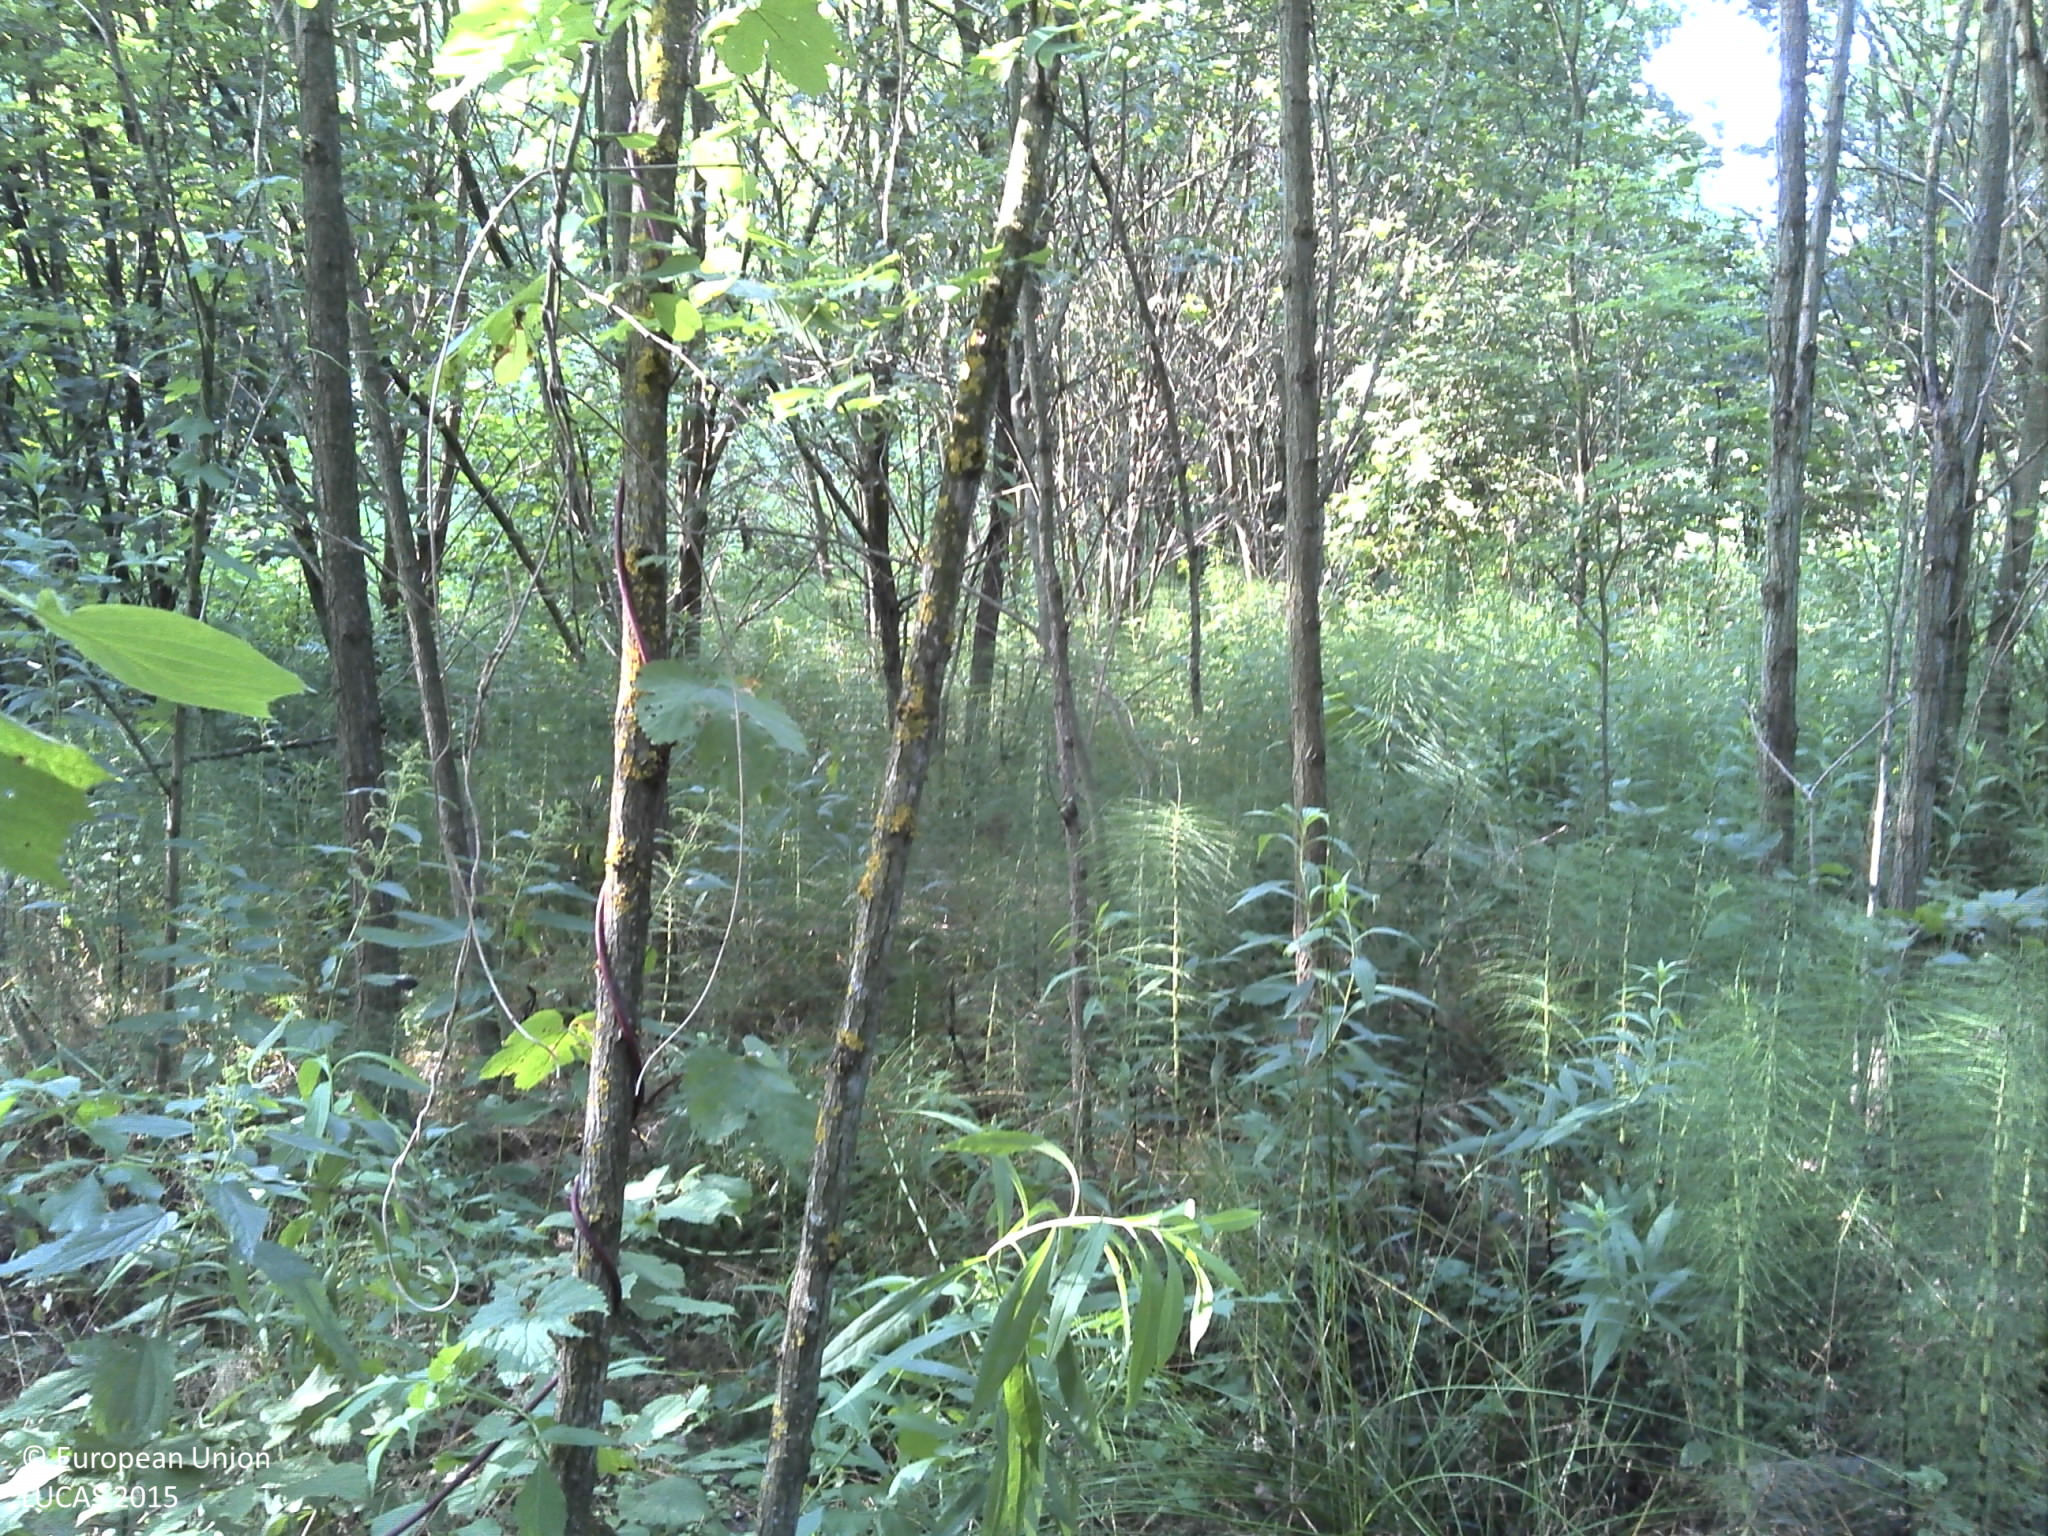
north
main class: Shrubland
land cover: Shrubland with sparse tree cover
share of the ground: > 75 %
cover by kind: shrubs 95 %, broadleaved forest trees 5 %
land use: Semi-natural and natural areas not in use
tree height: < 5 m
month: July
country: HR
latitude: 45.5073
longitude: 16.7184
